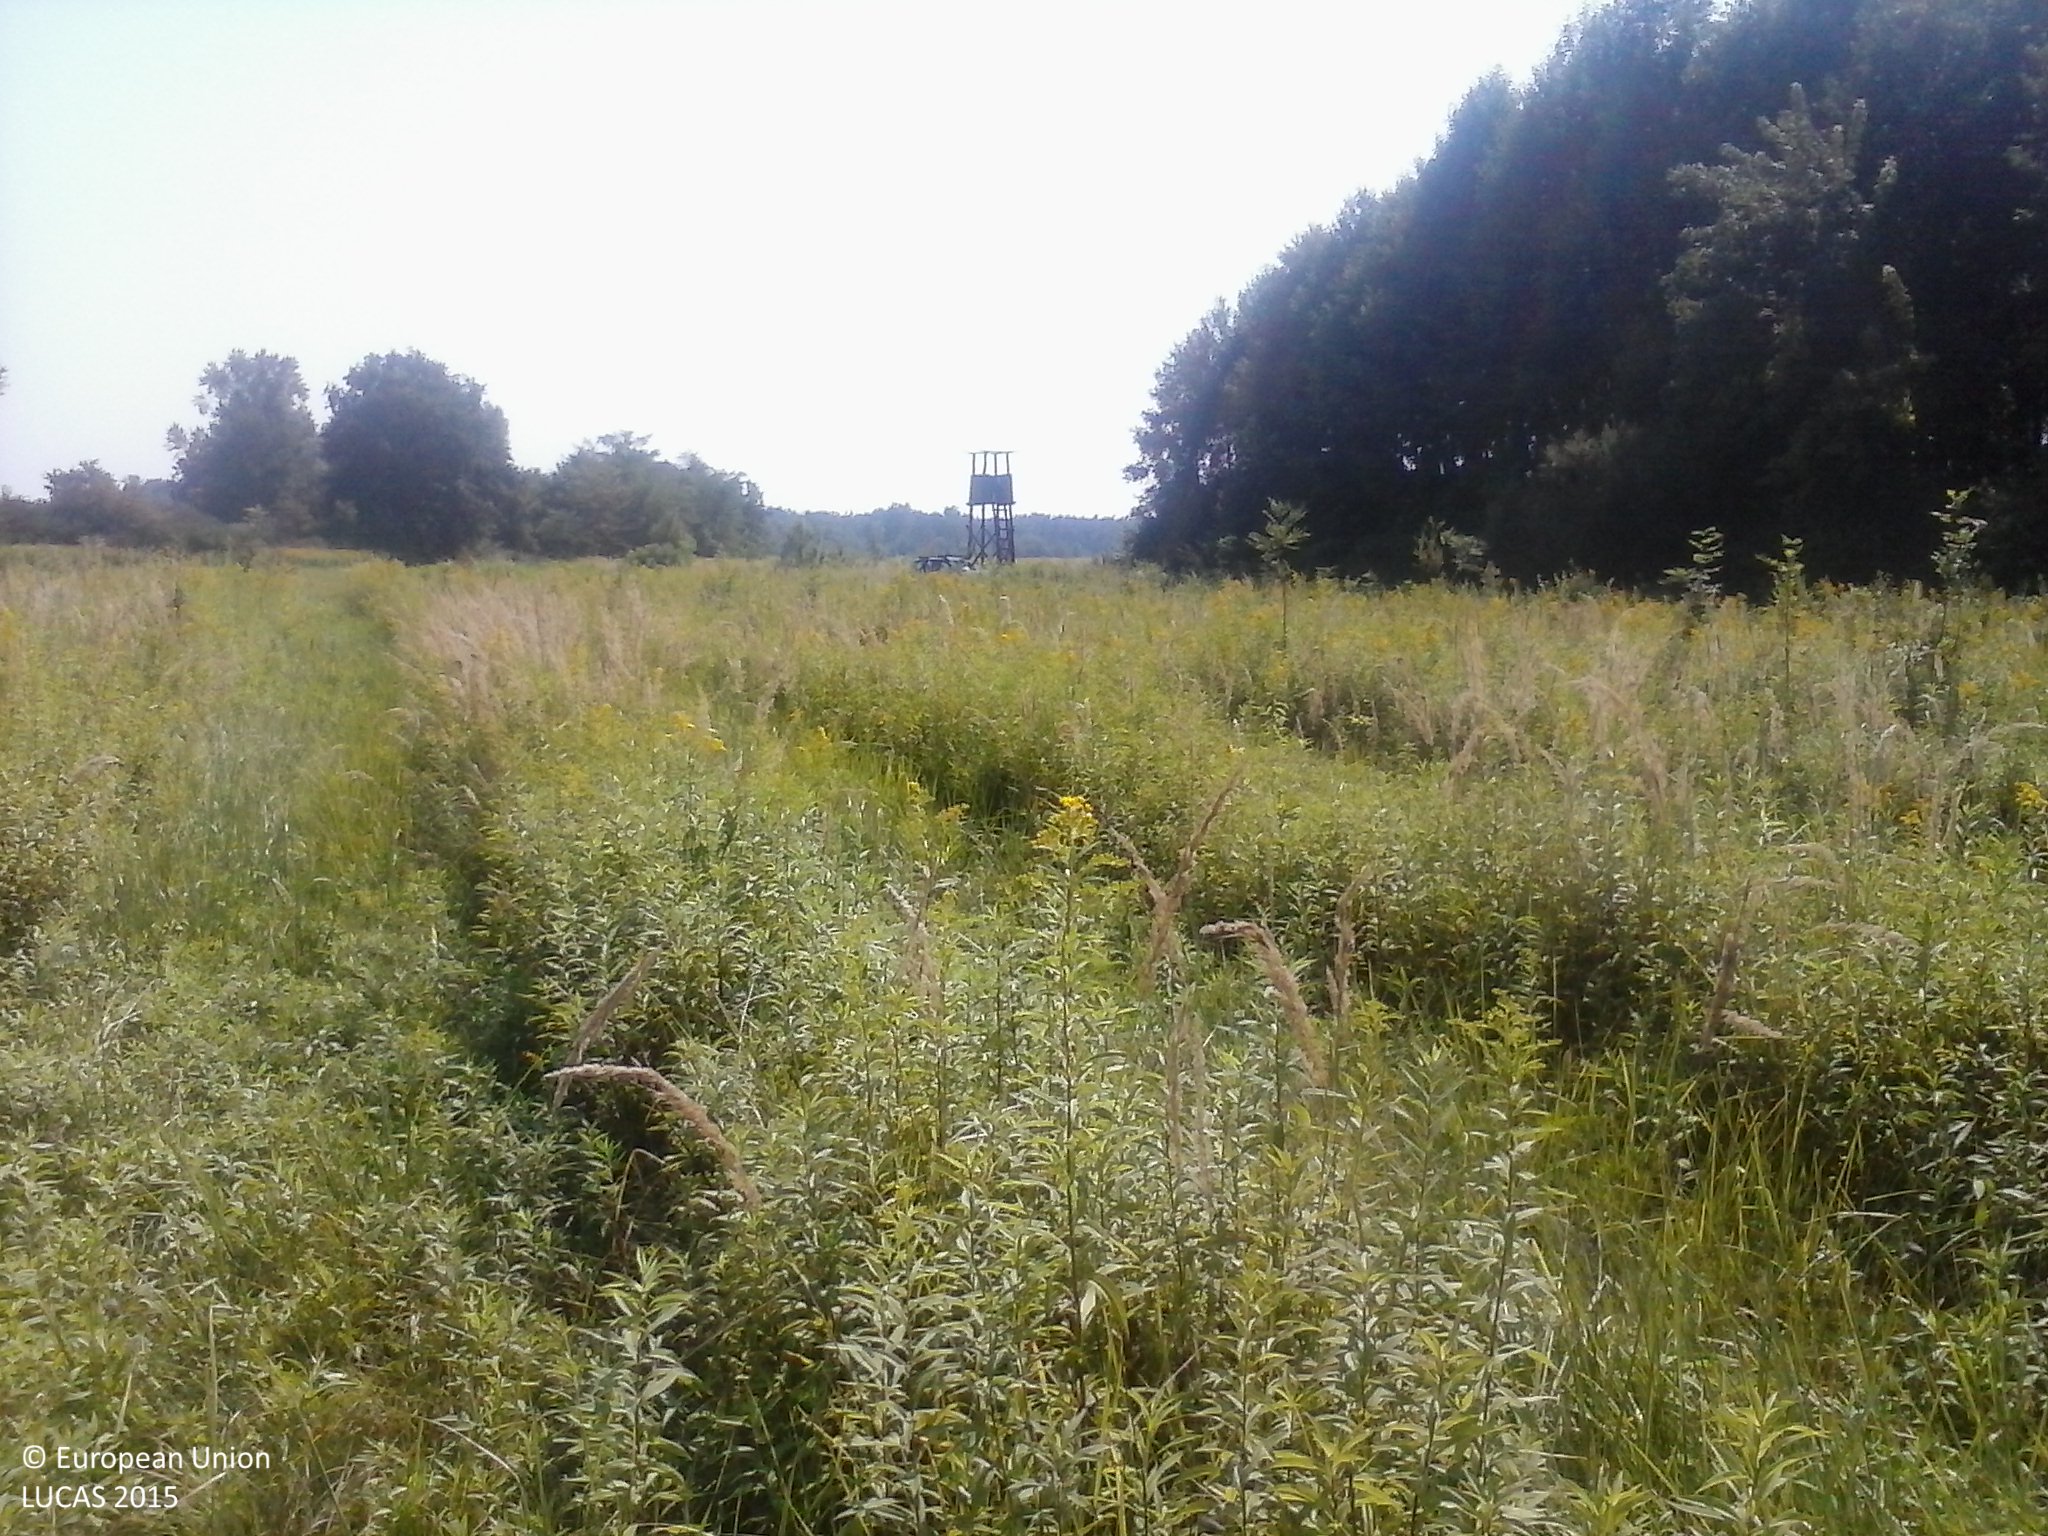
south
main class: Woodland
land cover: Broadleaved woodland
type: acidophilous oak and oak-birch forest
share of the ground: 10 - 25 %
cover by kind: herbaceous plants 80 %, broadleaved forest trees 10 %, shrubs 10 %
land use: Forestry
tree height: < 5 m
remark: Nursery
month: August
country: HU
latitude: 45.8021
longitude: 17.9433
